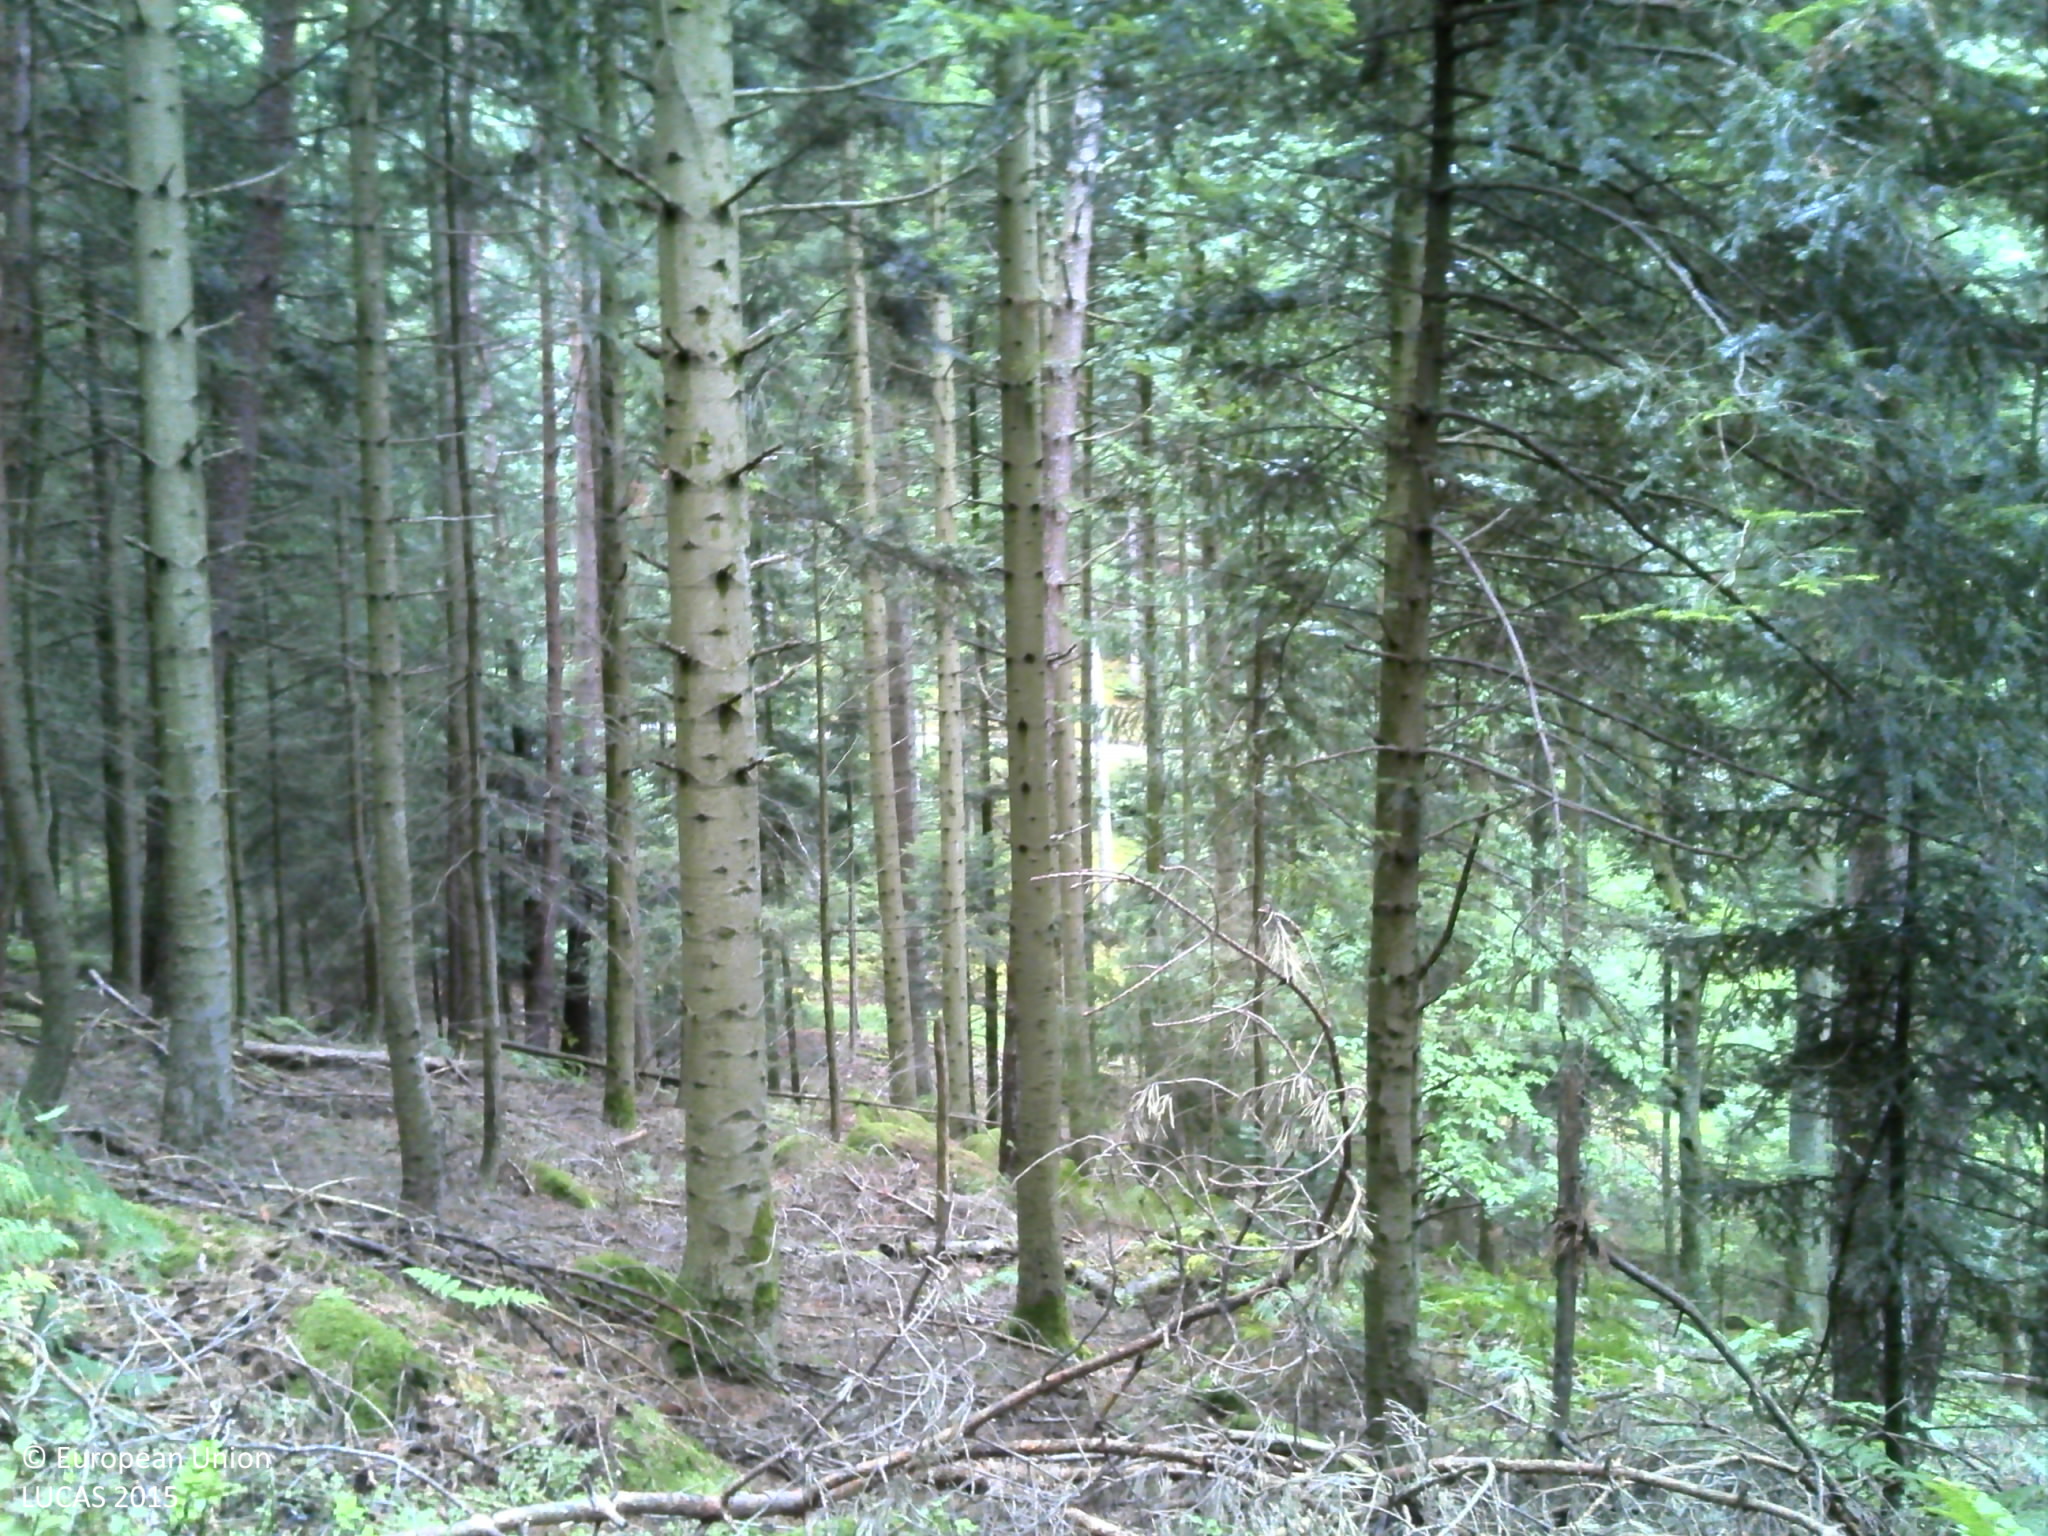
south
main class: Woodland
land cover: Spruce dominated coniferous woodland
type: exotic forest
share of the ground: > 75 %
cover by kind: coniferous forest trees 80 %, herbaceous plants 10 %, consolidated bare surface 5 %, unconsolidated bare surface 5 %
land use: Forestry
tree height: > 5 m
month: September
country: FR
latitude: 48.4268
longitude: 7.3926
